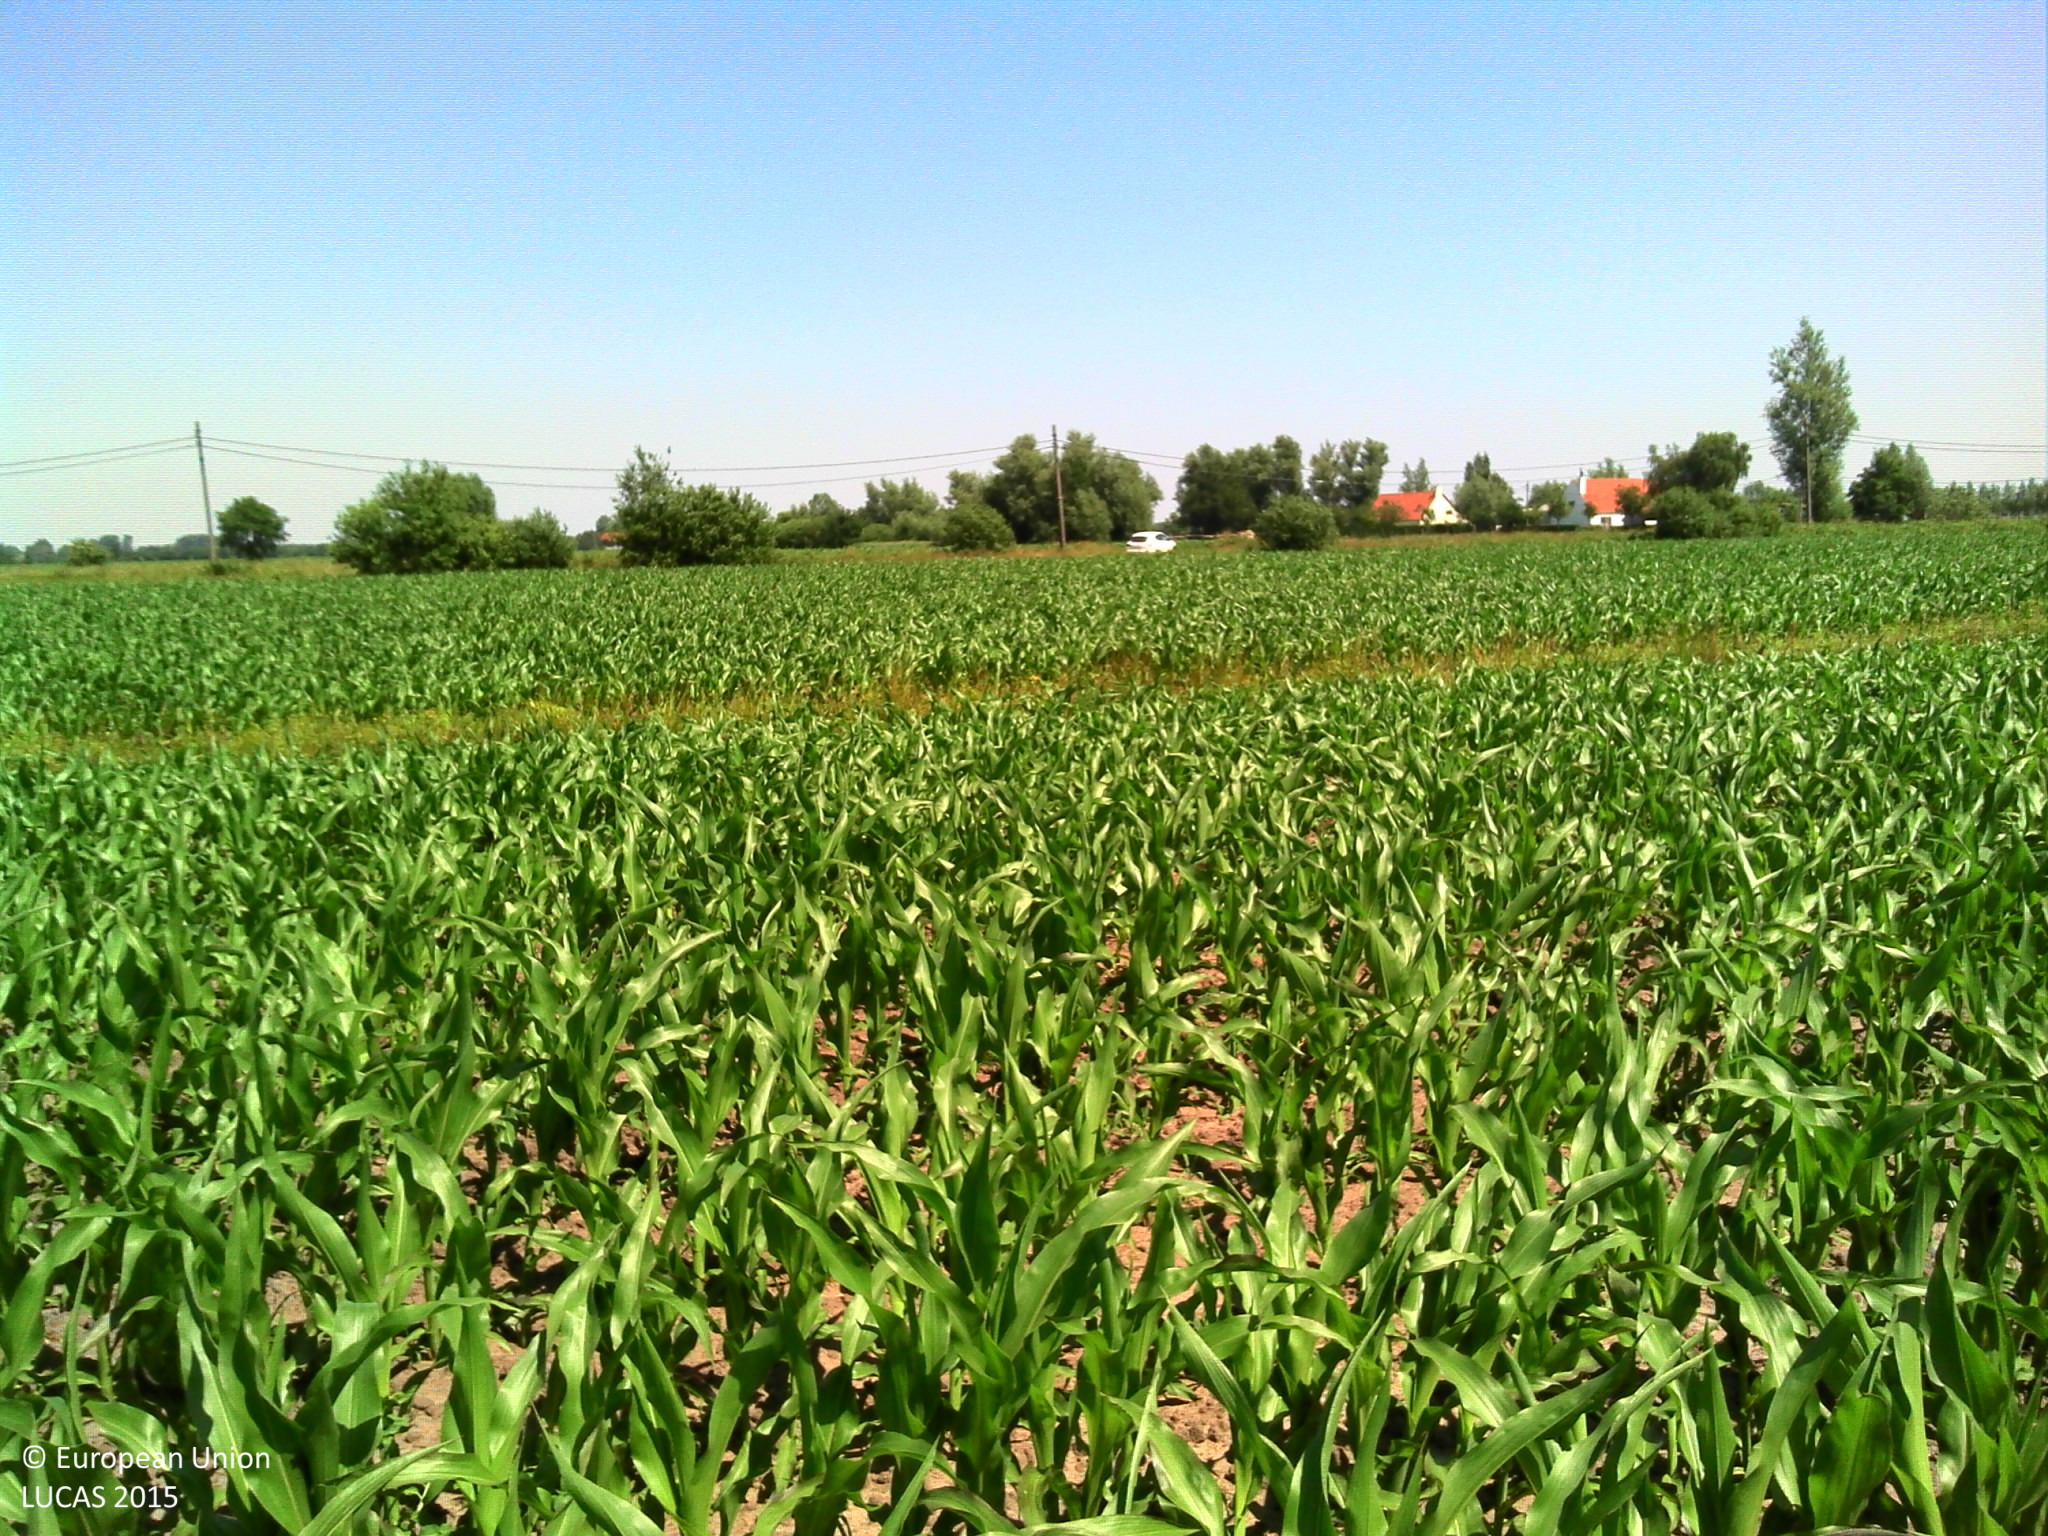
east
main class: Cropland
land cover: Maize
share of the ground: > 75 %
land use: Agriculture (excluding fallow land and kitchen gardens)
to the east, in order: Maize; Grass margins; Ditches and canals; Grass margins; Maize; Grass margins; Ditches and canals; Grass margins; Paved roads, cycling and walking lanes; Grass margins; Electric lines; Ditches and canals; Grass margins; Maize; Grass margins; Ditches and canals; Grass margins; Maize
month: June
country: BE
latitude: 51.2157
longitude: 3.6506
